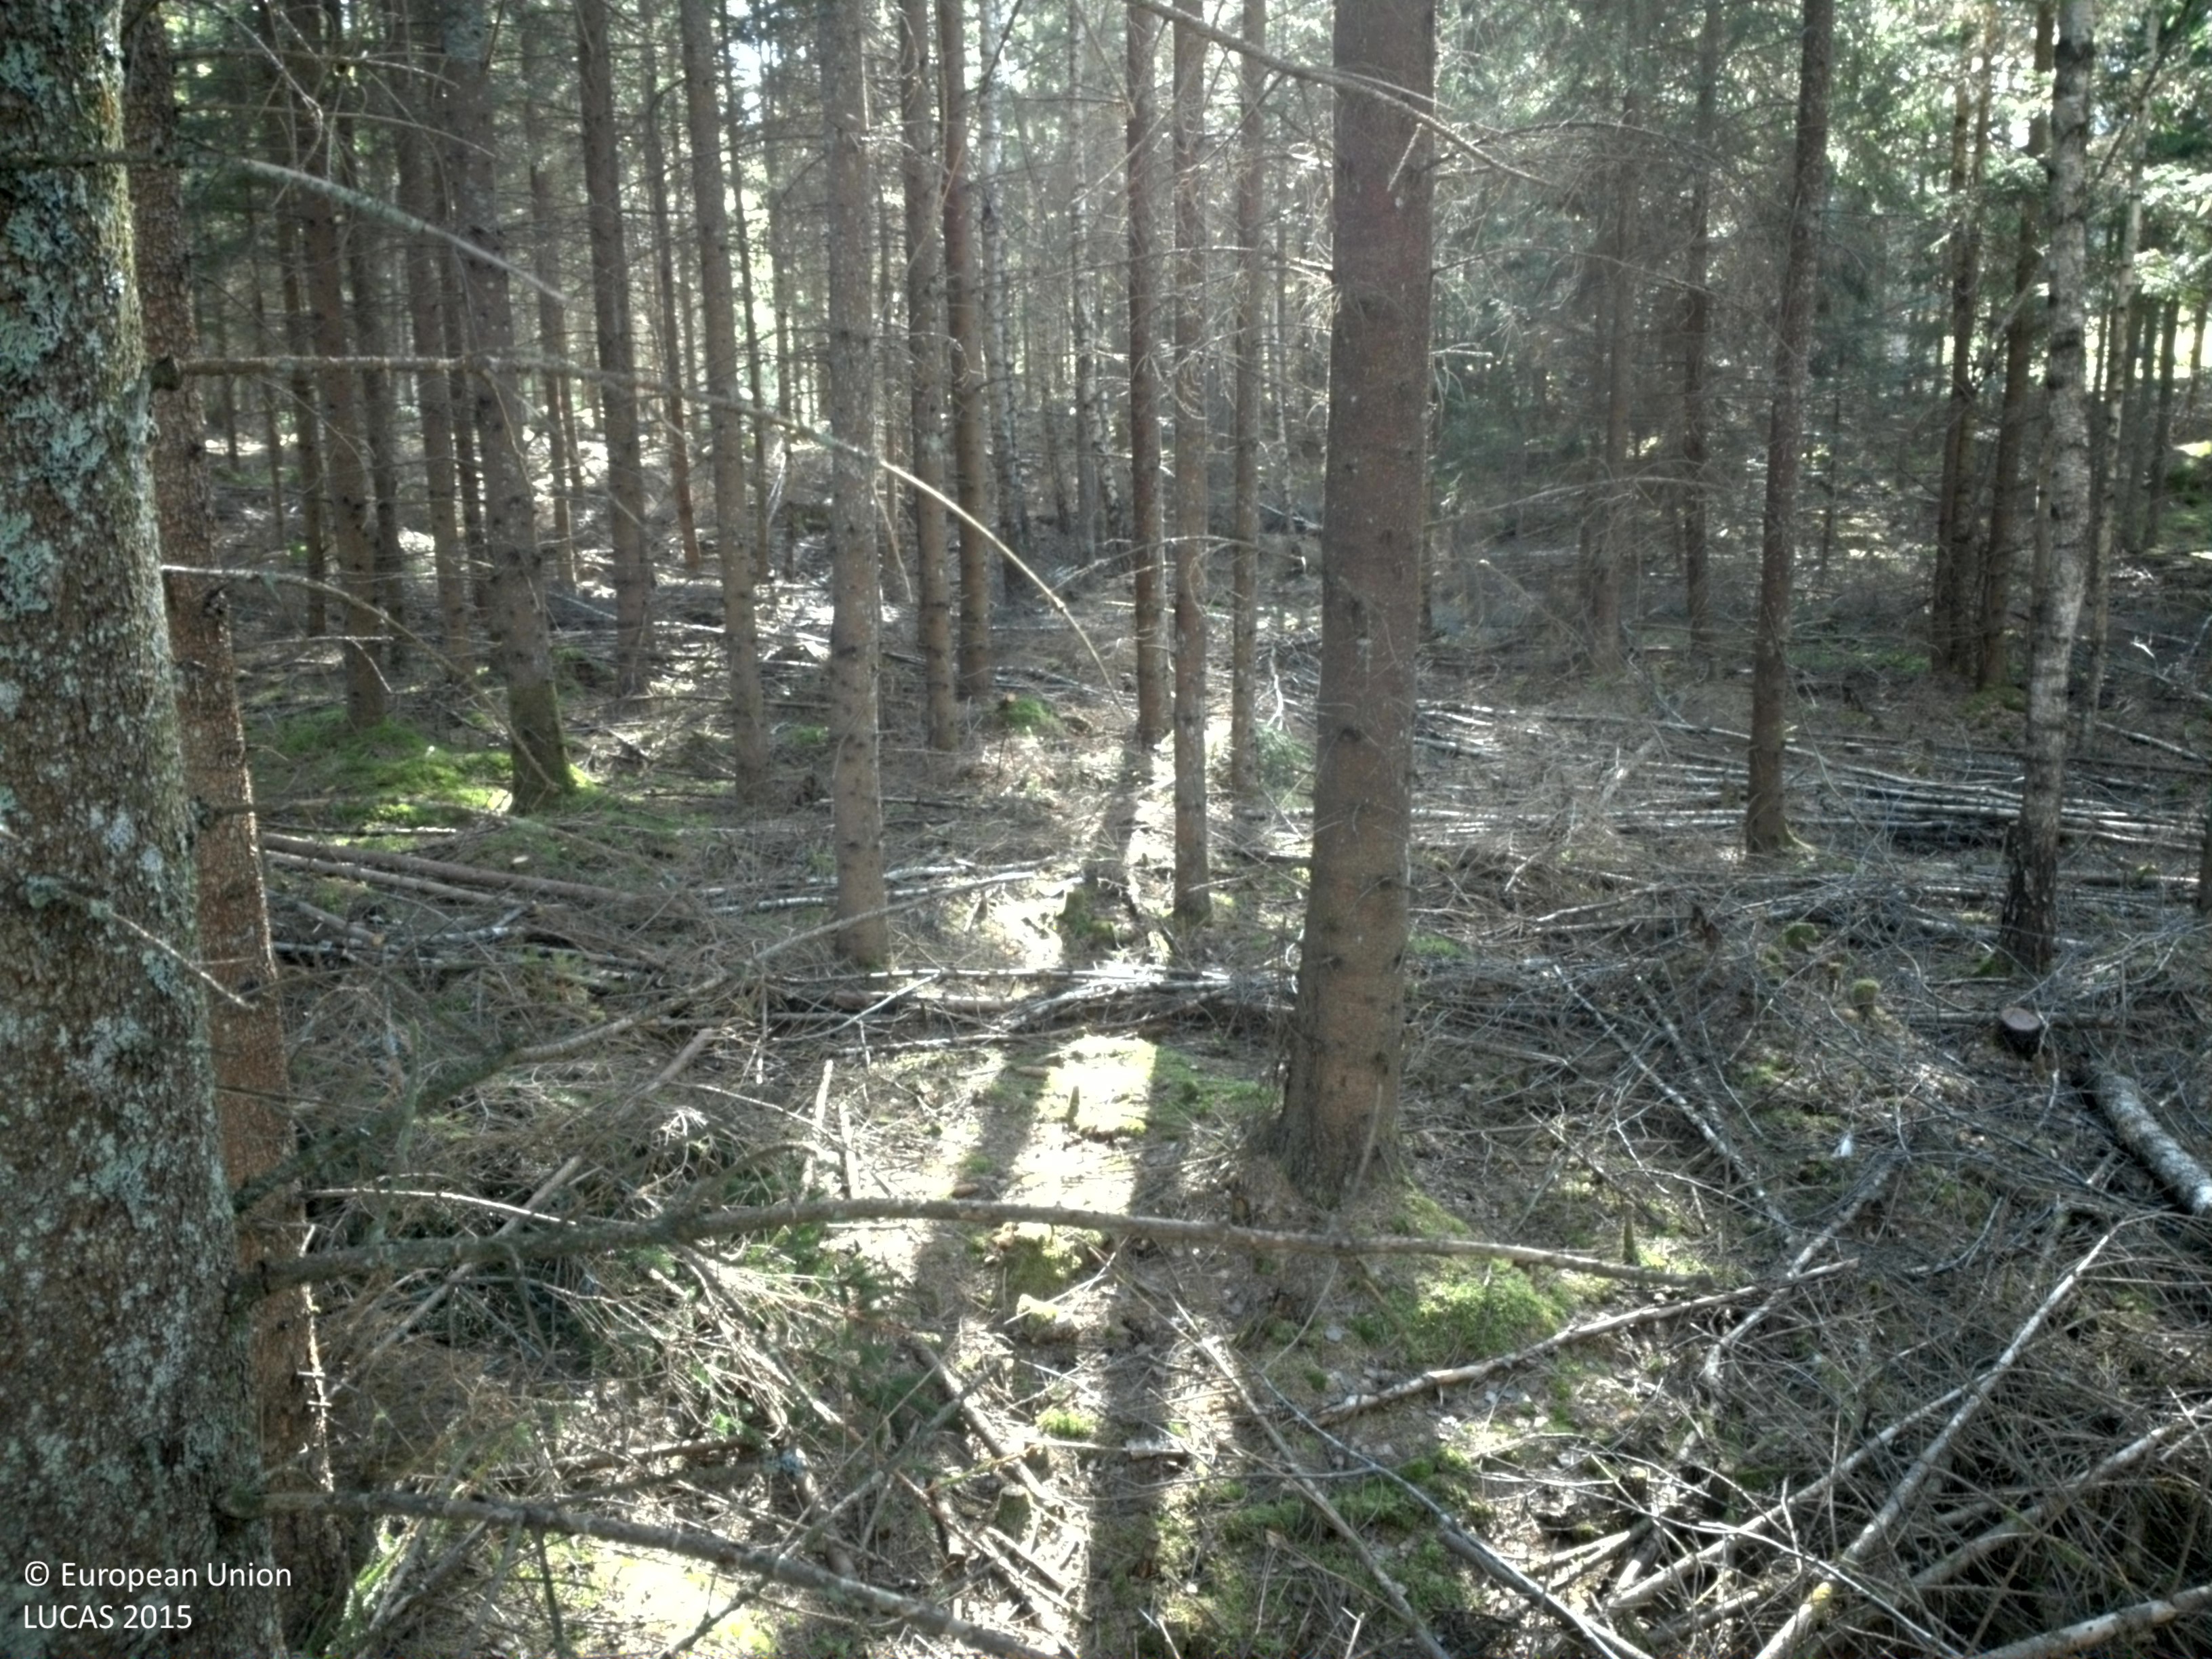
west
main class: Woodland
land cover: Spruce dominated coniferous woodland
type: boreal forest
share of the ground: > 75 %
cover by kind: coniferous forest trees 80 %, lichens and mosses 15 %, broadleaved forest trees 5 %
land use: Forestry
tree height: > 5 m
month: May
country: SE
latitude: 56.5667
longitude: 15.2549
